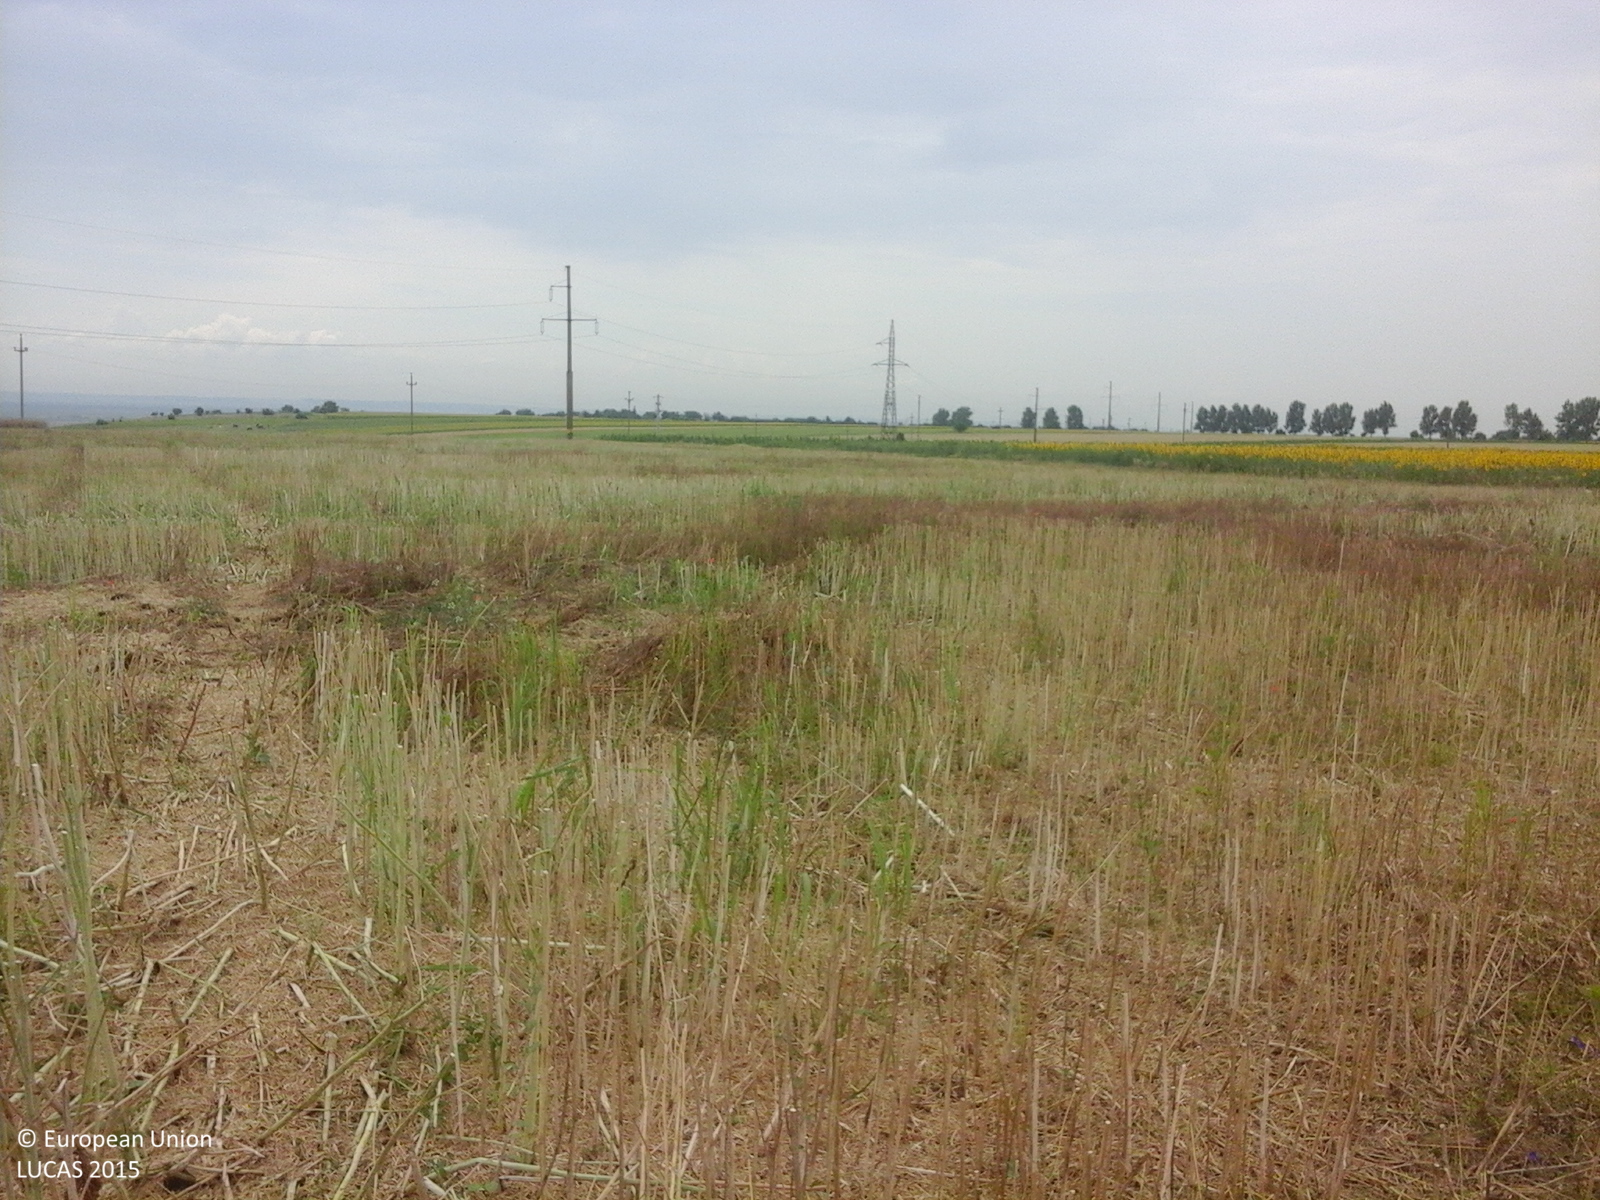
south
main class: Cropland
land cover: Rape and turnip rape
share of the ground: < 10 %
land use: Agriculture (excluding fallow land and kitchen gardens)
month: July
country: RO
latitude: 44.0305
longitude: 26.0327
